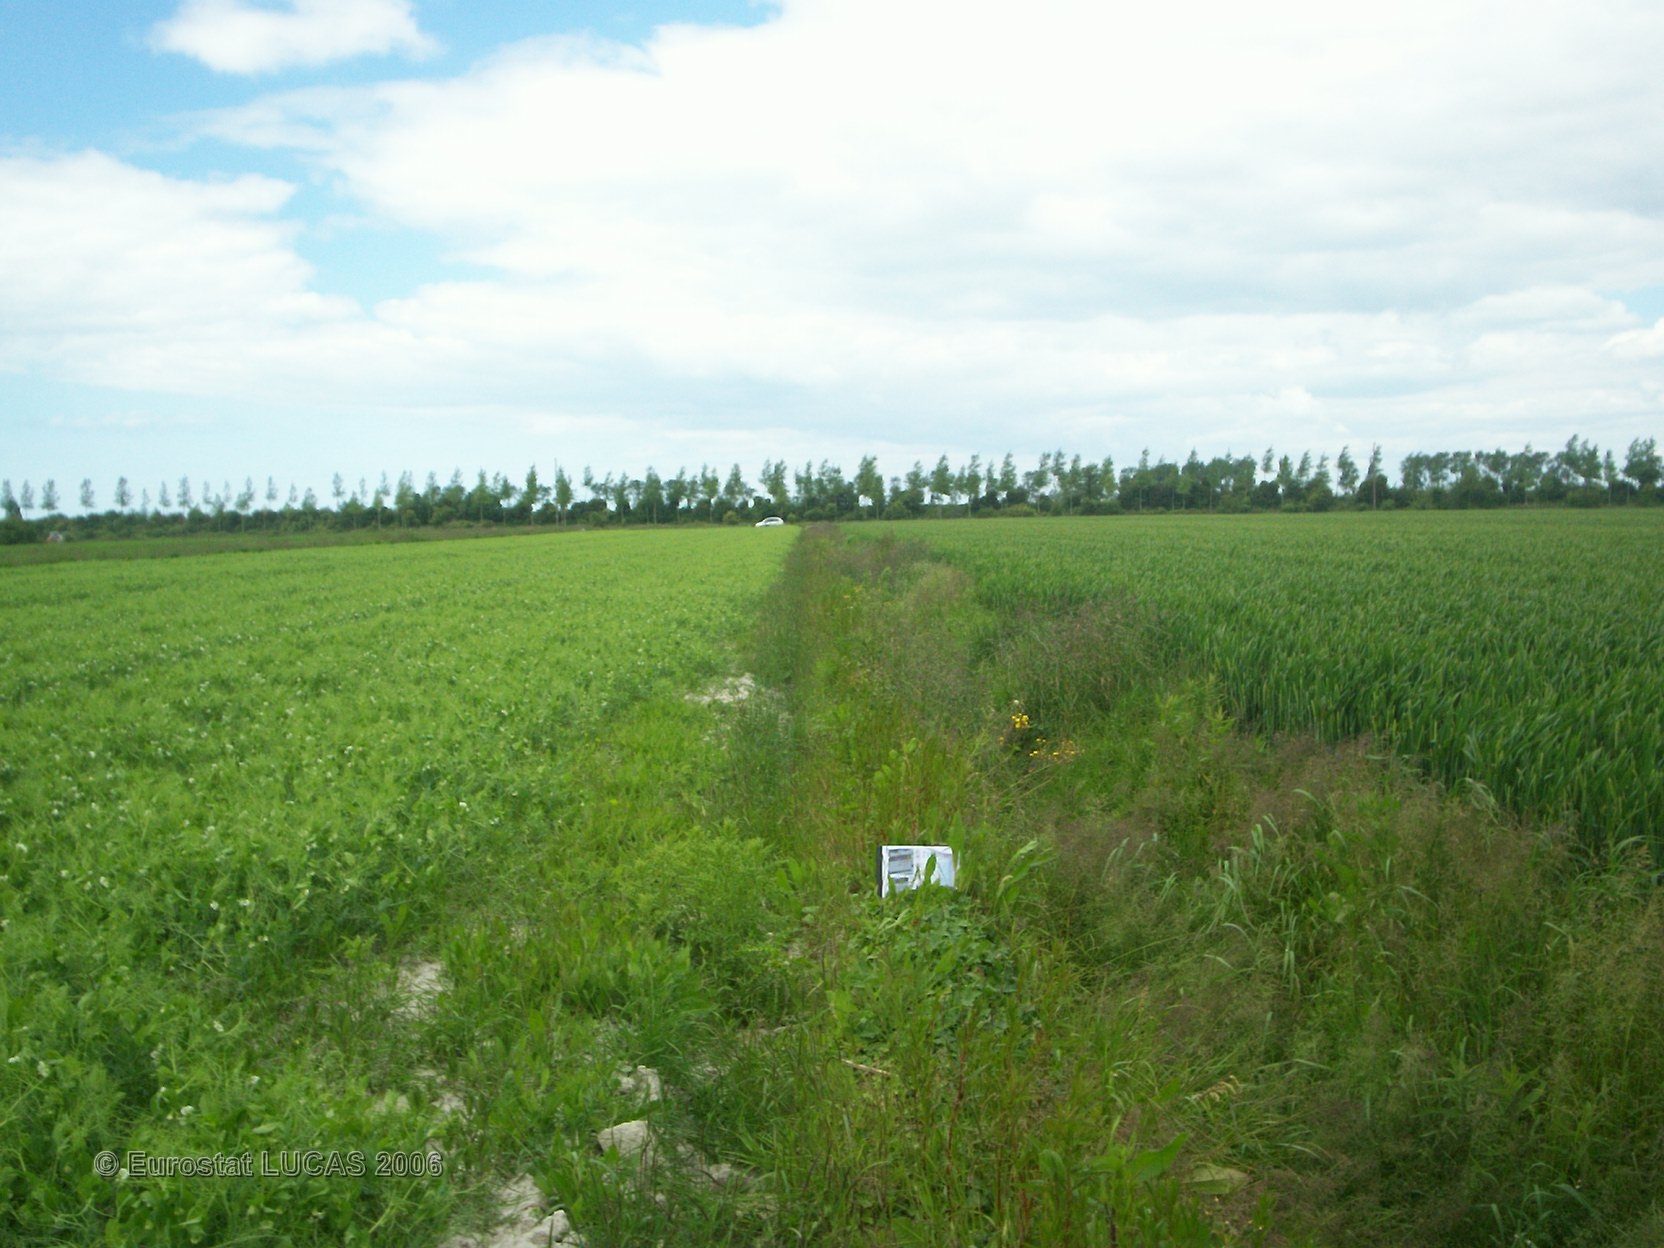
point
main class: Cropland
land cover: Barley
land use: Agriculture (excluding fallow land and kitchen gardens)
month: May
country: FR
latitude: 48.6039
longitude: -1.6444
